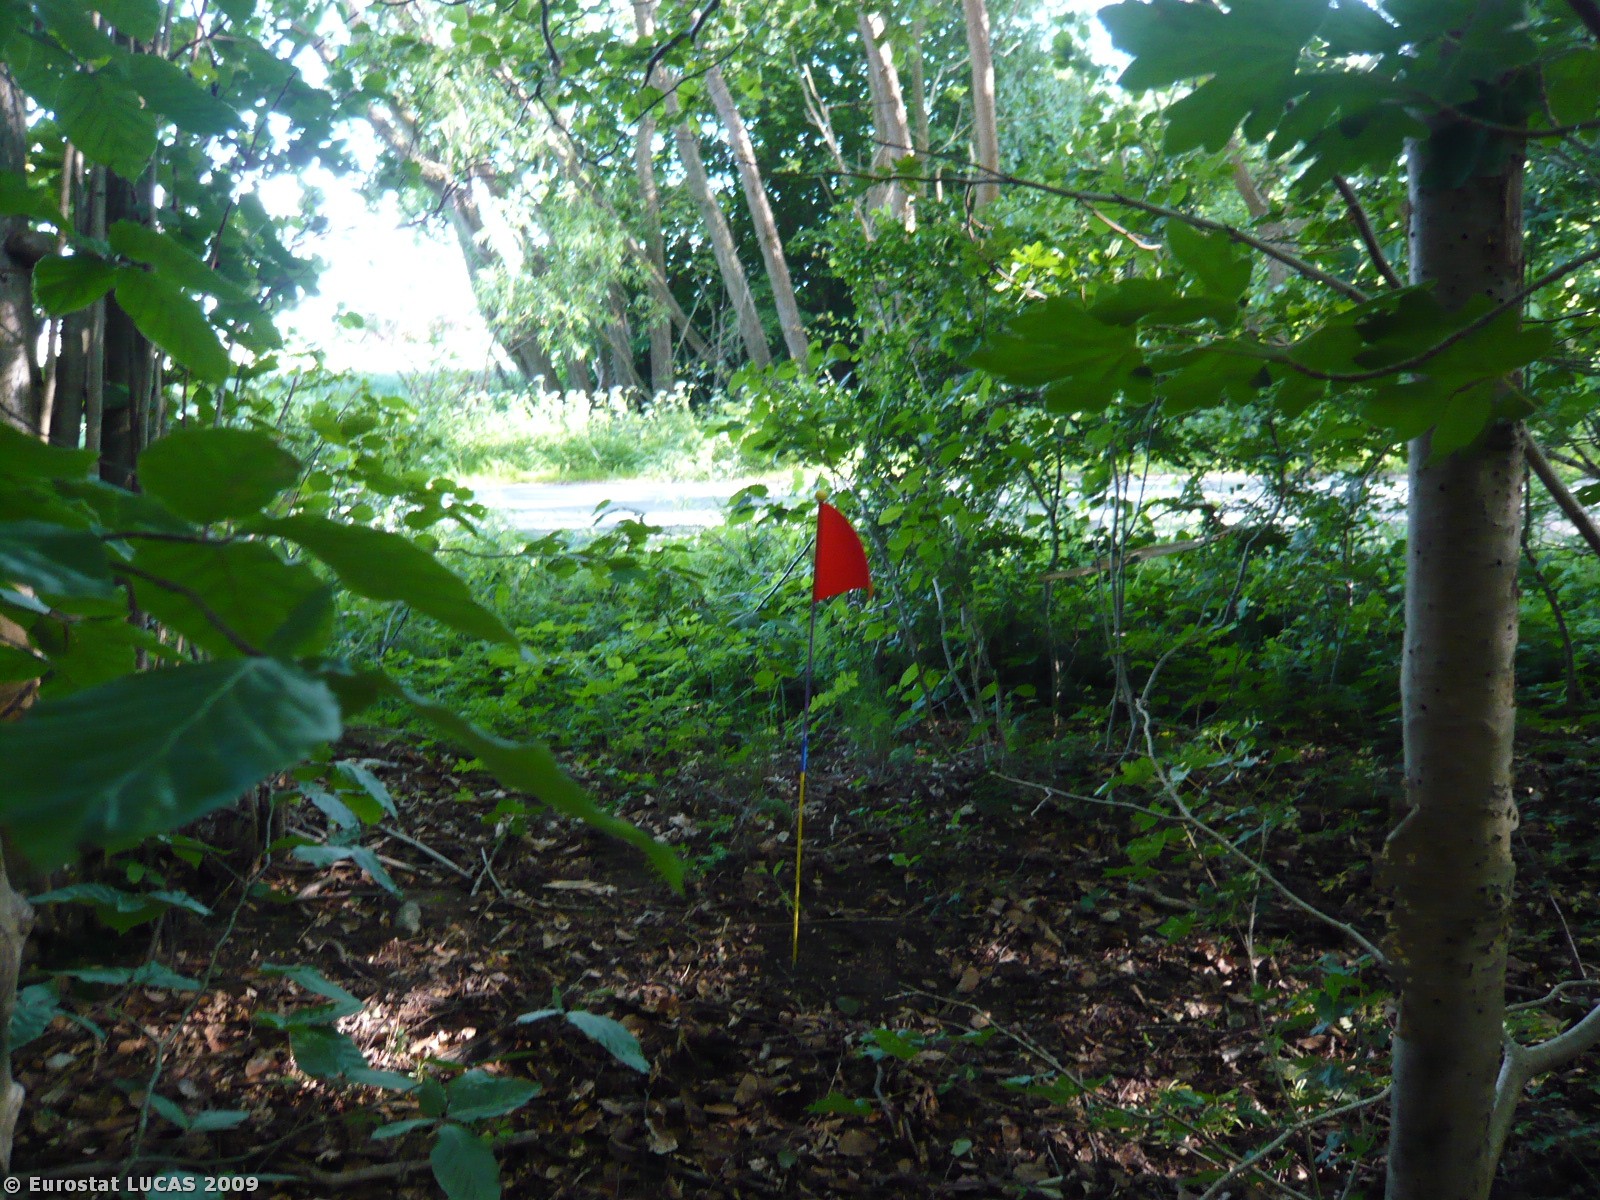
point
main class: Woodland
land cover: Broadleaved woodland
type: mesophytic deciduous forest
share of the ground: > 75 %
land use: Amenities, museums, leisure
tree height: > 5 m
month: June
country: DK
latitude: 54.8785
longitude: 11.9470
